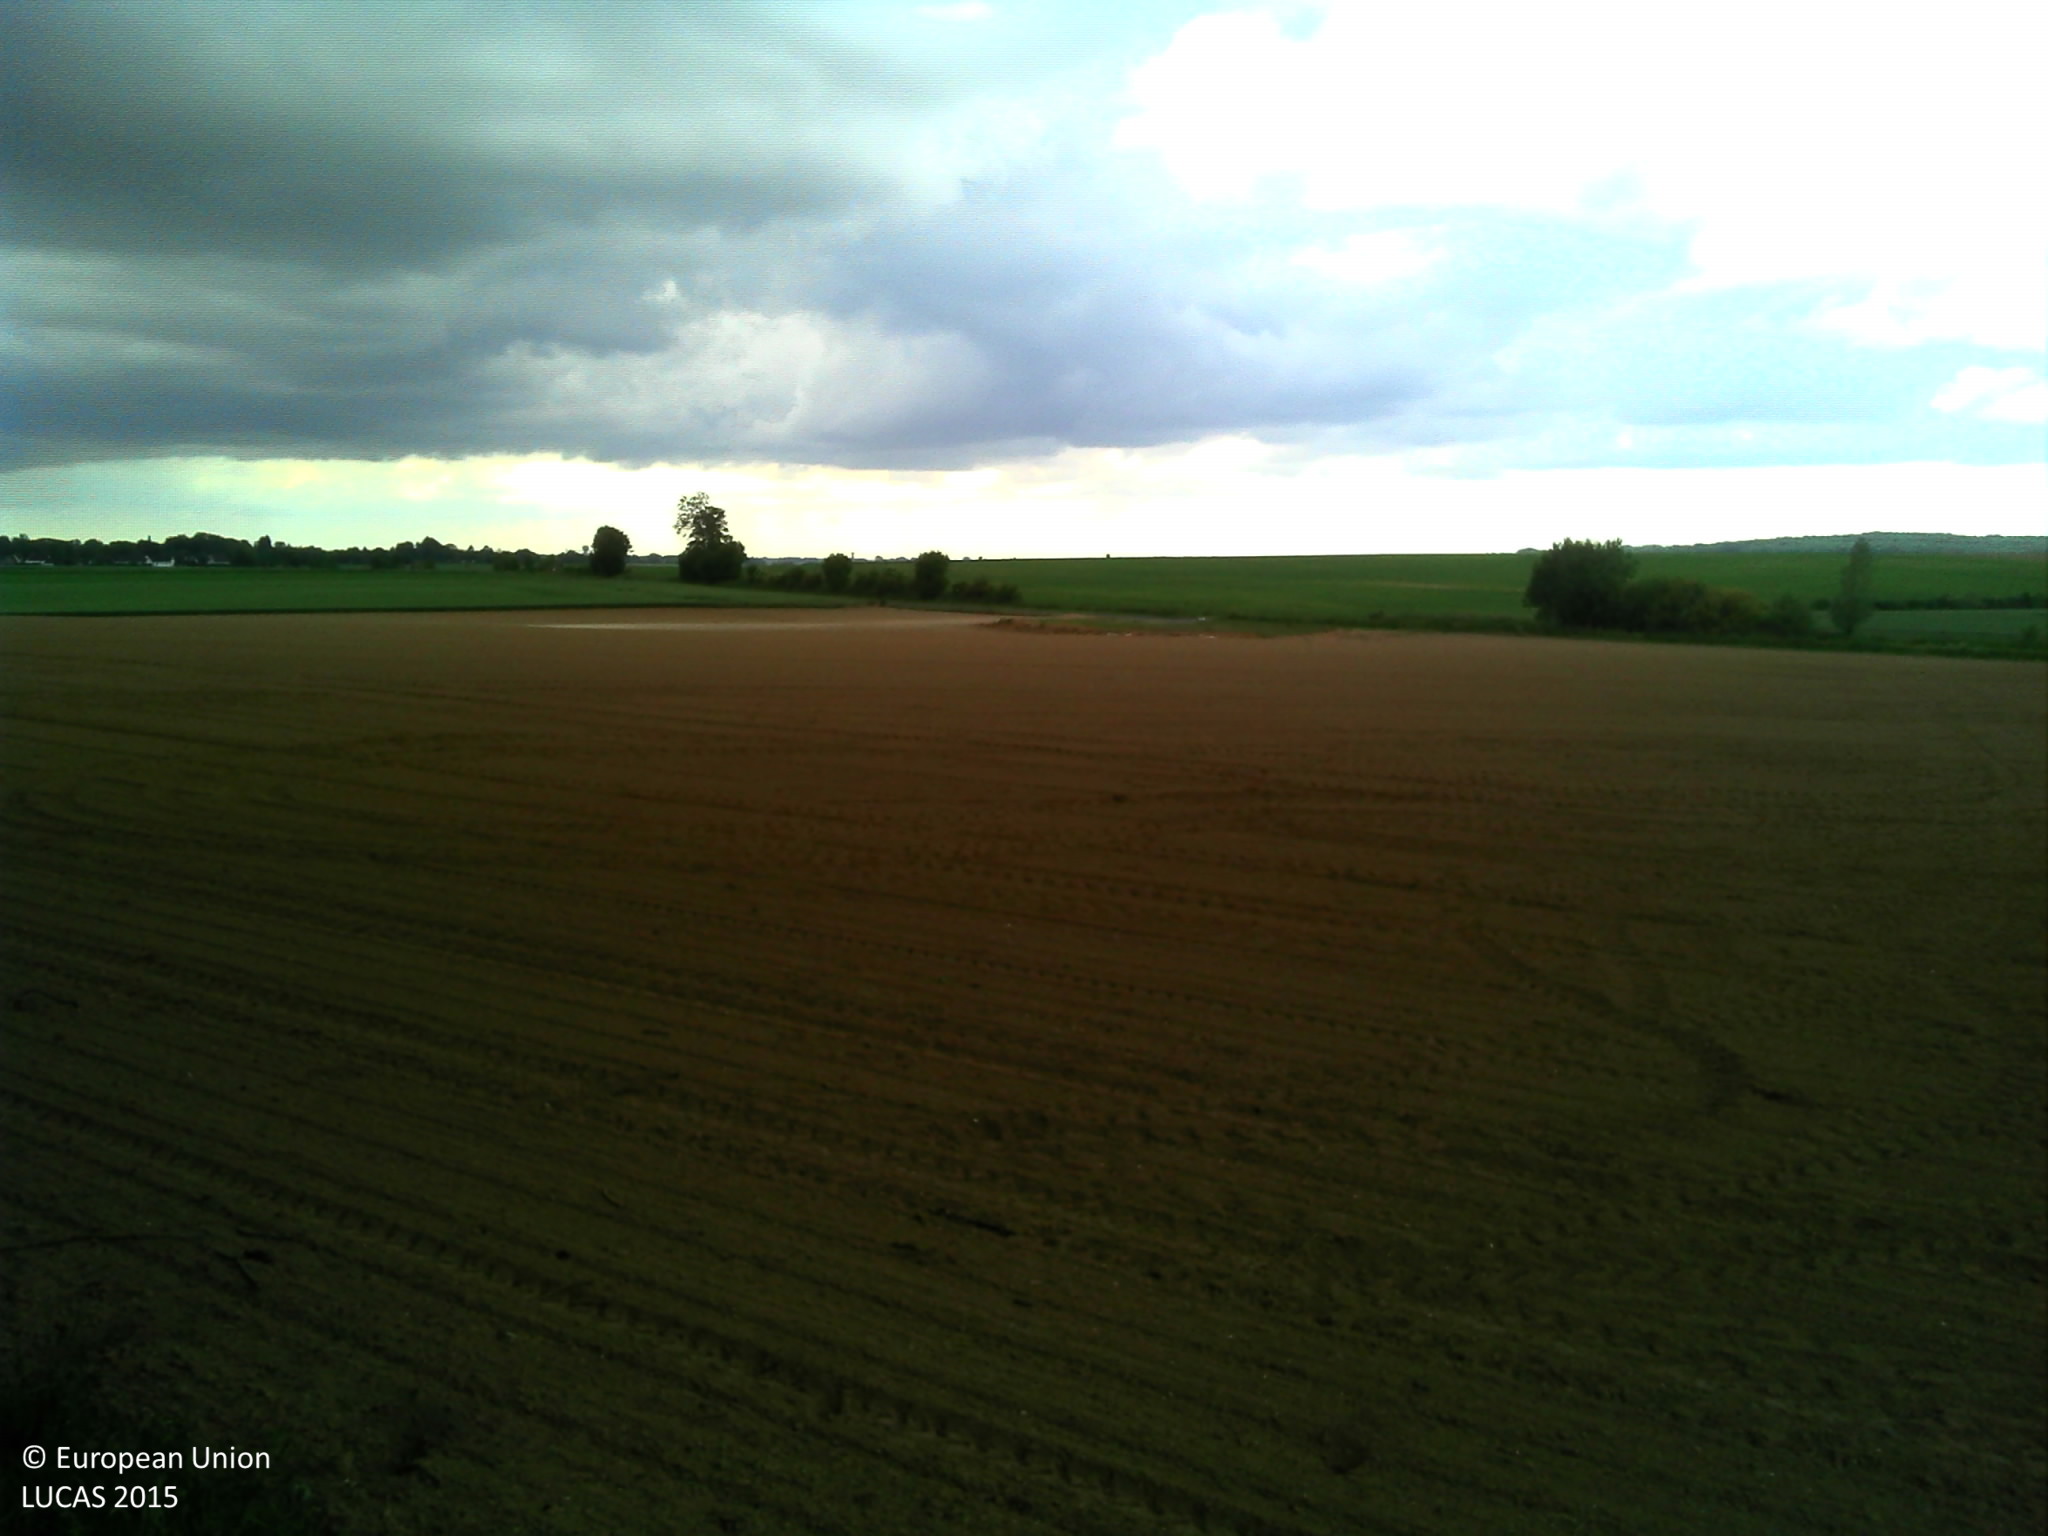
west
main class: Grassland
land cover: Grassland with sparse tree/shrub cover
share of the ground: > 75 %
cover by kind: herbaceous plants 95 %, broadleaved forest trees 5 %
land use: Residential
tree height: > 5 m
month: May
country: FR
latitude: 49.8380
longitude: 3.2200
